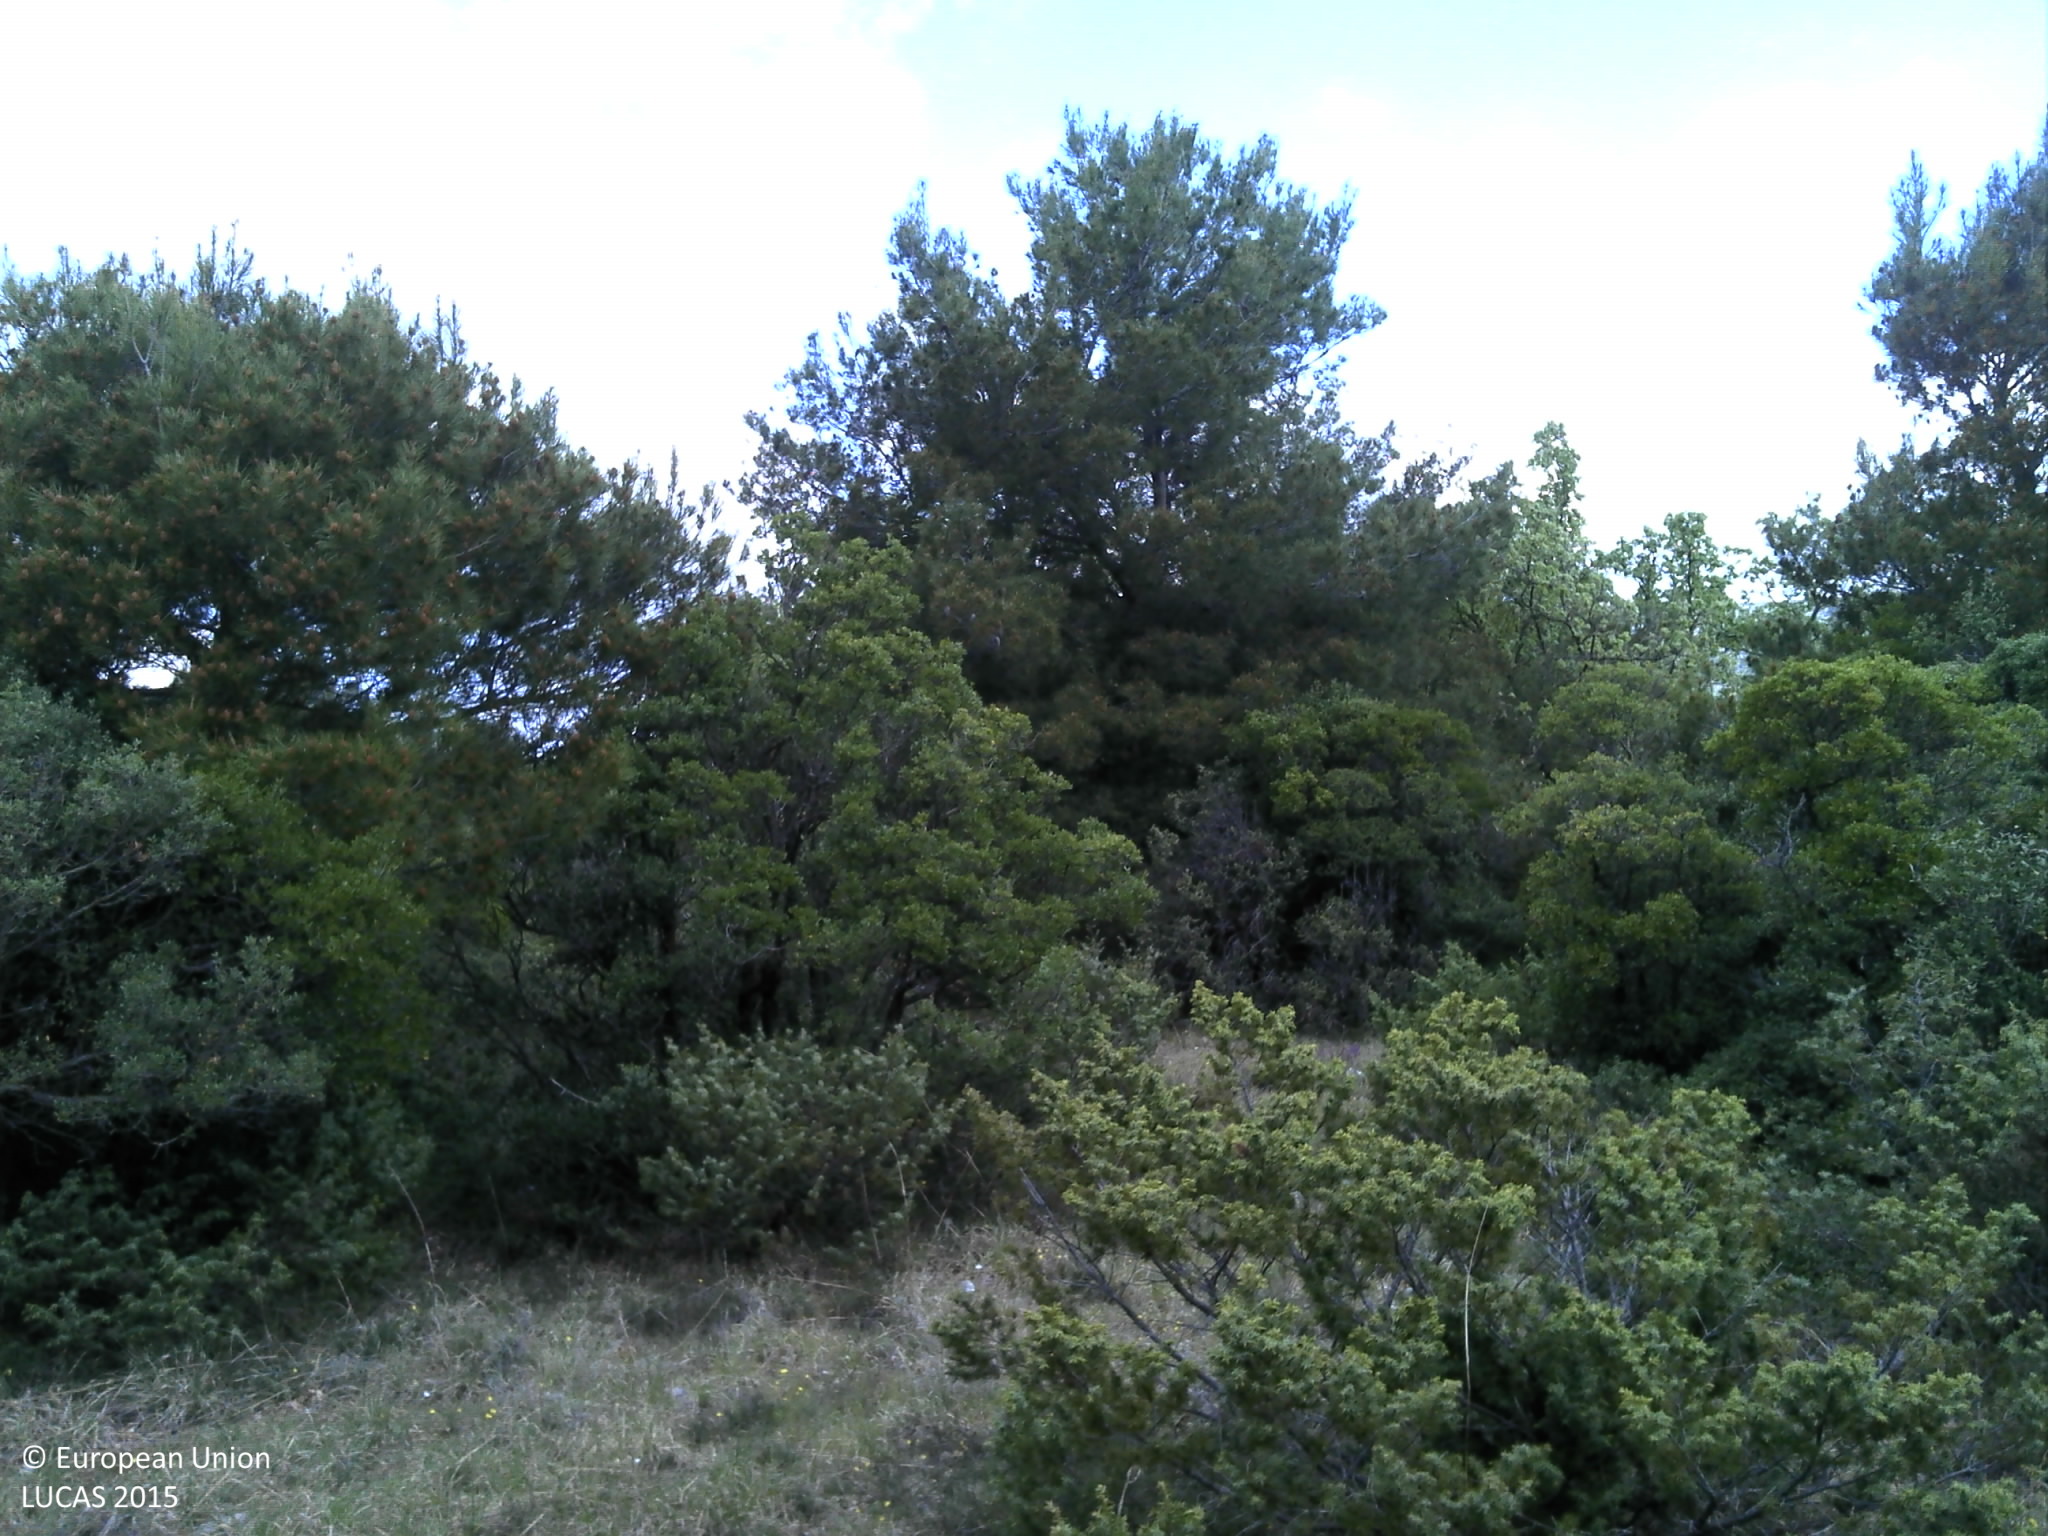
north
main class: Woodland
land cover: Pine dominated coniferous woodland
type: coniferous forest of the mediterranean region
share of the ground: 50 - 75 %
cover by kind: coniferous forest trees 50 %, shrubs 20 %, herbaceous plants 20 %, broadleaved forest trees 5 %, unconsolidated bare surface 5 %
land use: Semi-natural and natural areas not in use
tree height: > 5 m
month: April
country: HR
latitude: 43.7270
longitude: 15.9623
